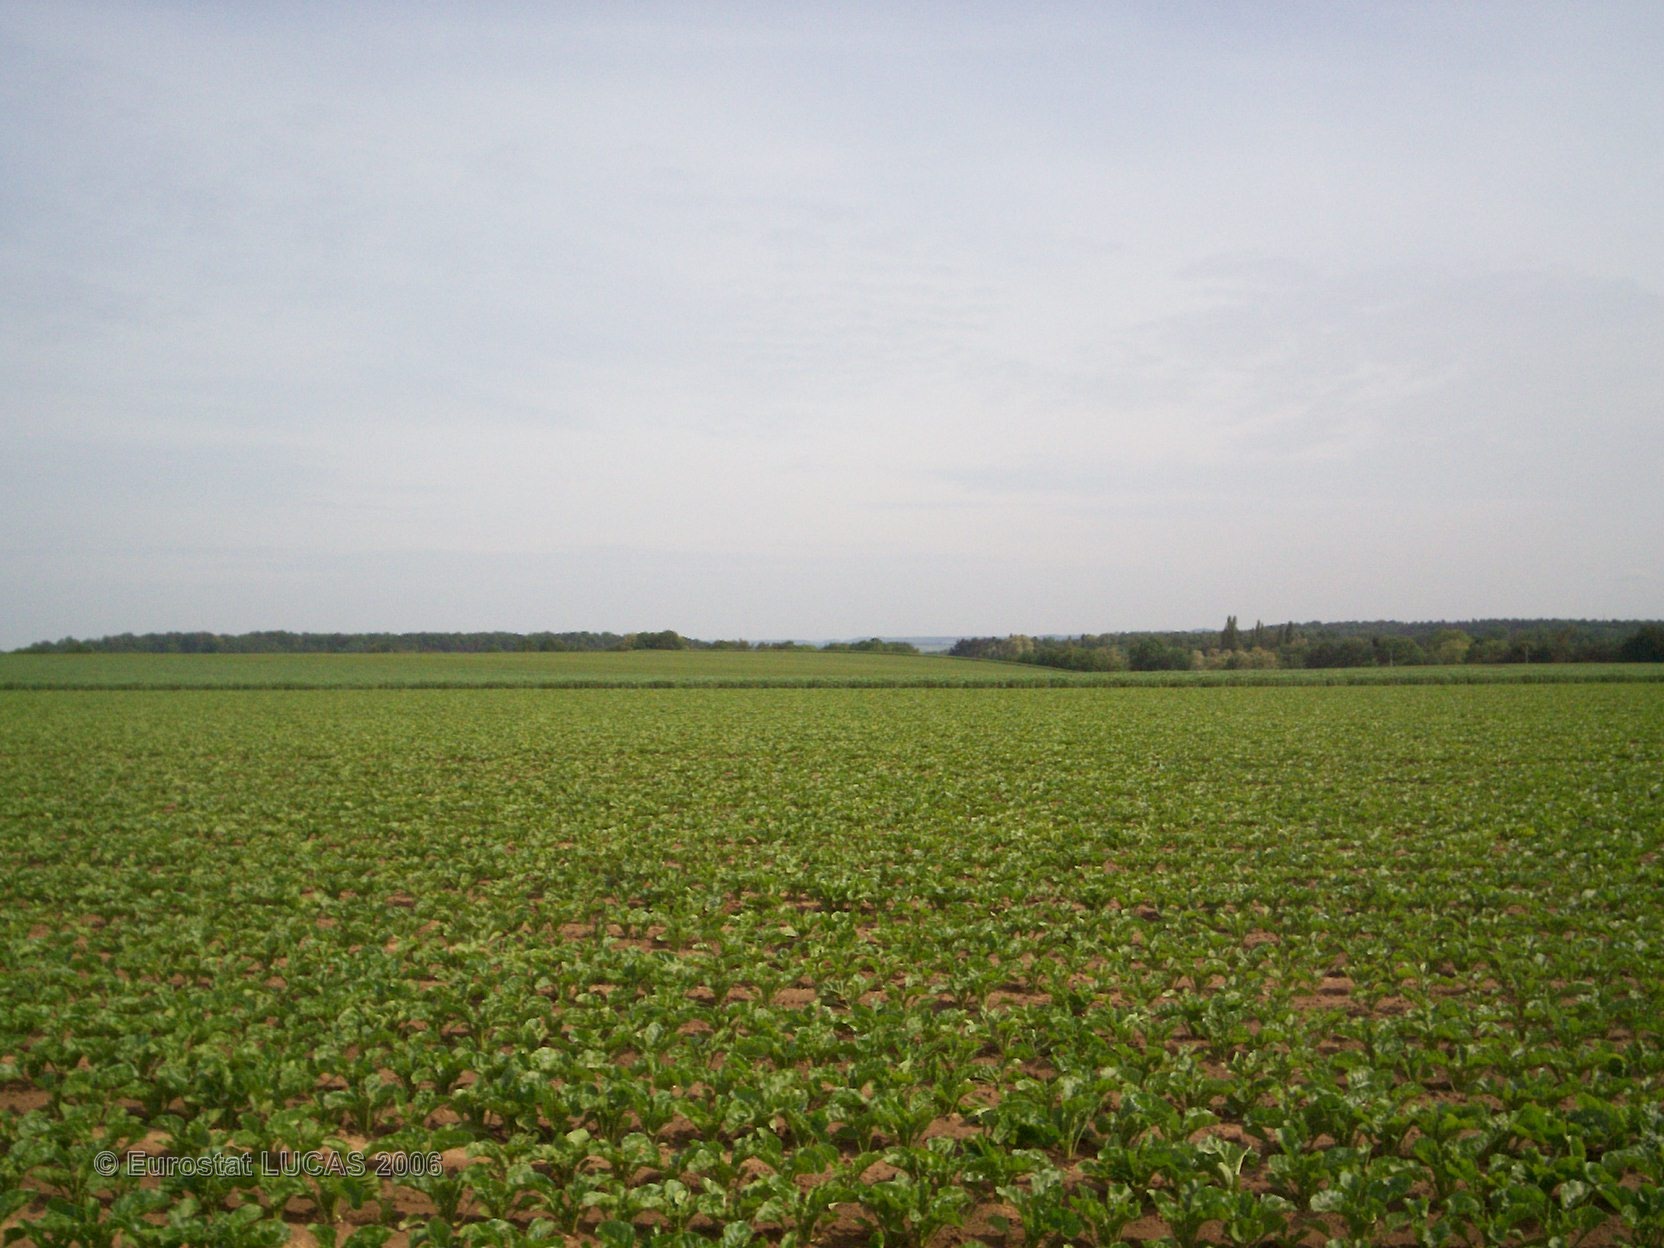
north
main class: Cropland
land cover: Sugar beet
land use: Agriculture (excluding fallow land and kitchen gardens)
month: June
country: FR
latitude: 49.2813
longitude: 2.6898
